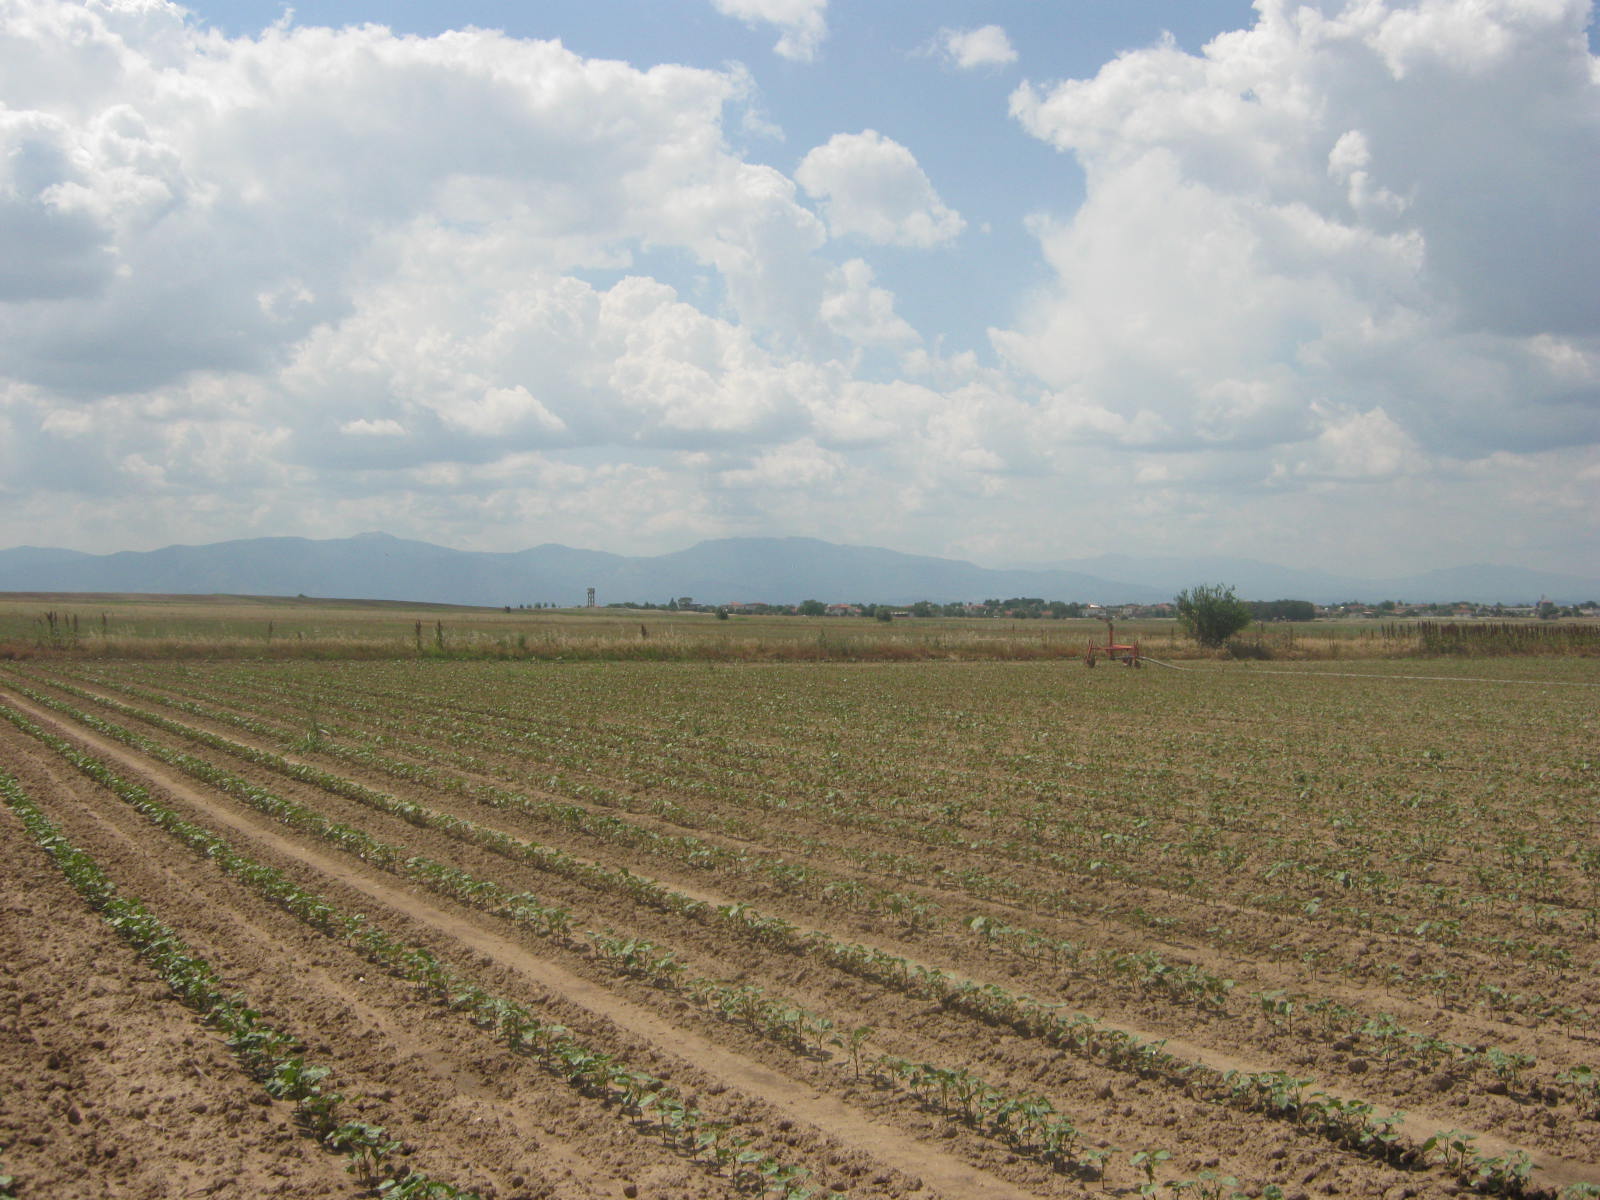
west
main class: Cropland
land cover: Cotton
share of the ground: < 10 %
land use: Agriculture (excluding fallow land and kitchen gardens)
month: June
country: GR
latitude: 40.8897
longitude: 22.6469
